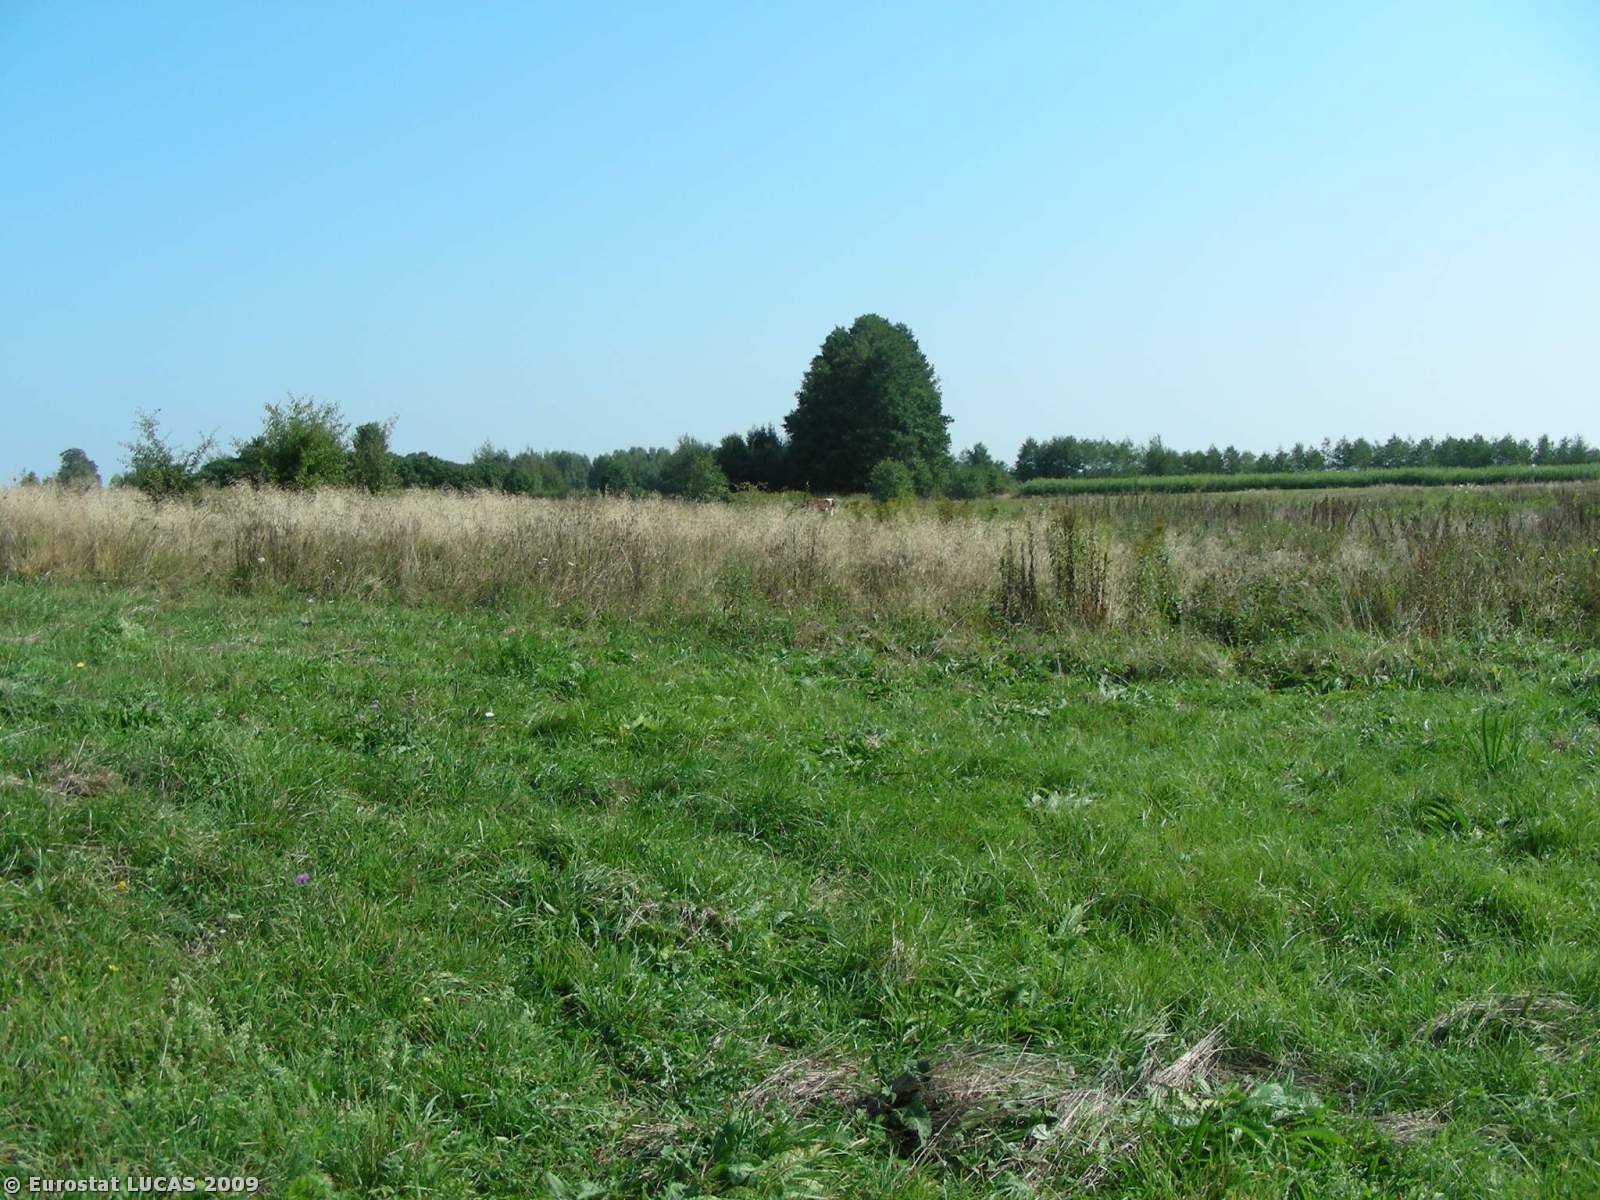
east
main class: Grassland
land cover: Grassland without tree/shrub cover
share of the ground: > 75 %
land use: Agriculture (excluding fallow land and kitchen gardens)
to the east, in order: Grassland without tree/shrub cover; Broadleaved woodland
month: September
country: PL
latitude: 50.5229
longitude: 22.2343
